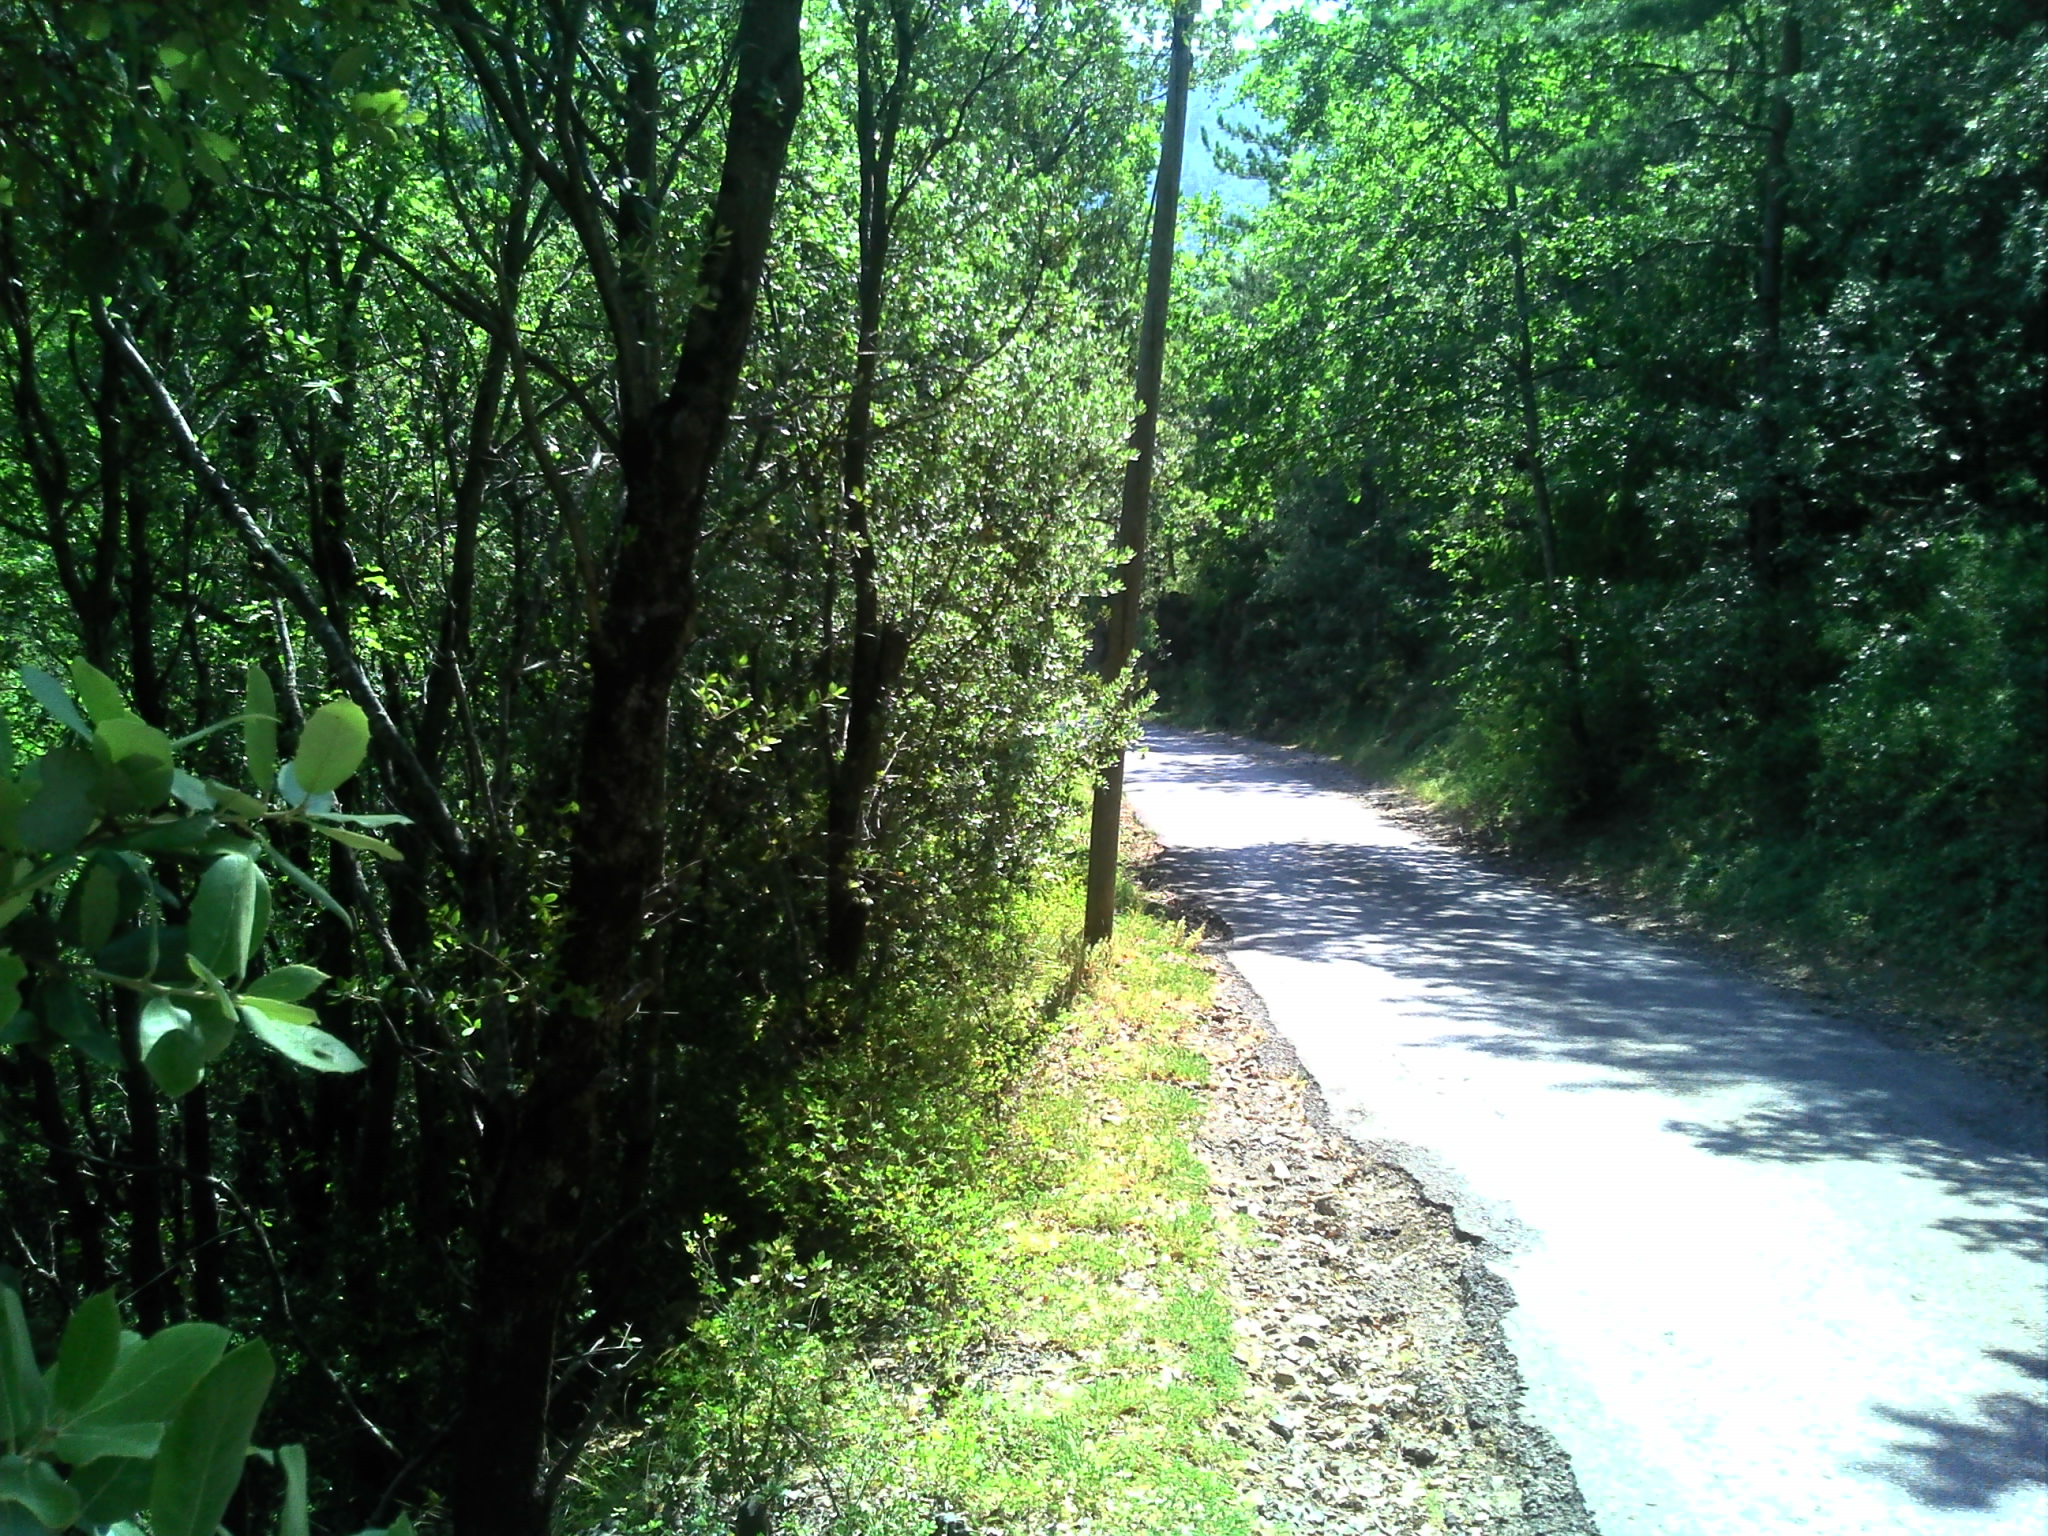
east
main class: Woodland
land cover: Broadleaved woodland
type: broadleaved evergreen forest
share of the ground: > 75 %
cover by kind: broadleaved forest trees 80 %, herbaceous plants 10 %, unconsolidated bare surface 10 %
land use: Forestry
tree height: > 5 m
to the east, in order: Broadleaved woodland; Electric lines; Broadleaved woodland; Tracks; Broadleaved woodland; Tracks; Broadleaved woodland; Olive groves
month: October
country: FR
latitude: 44.0072
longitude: 3.5840
